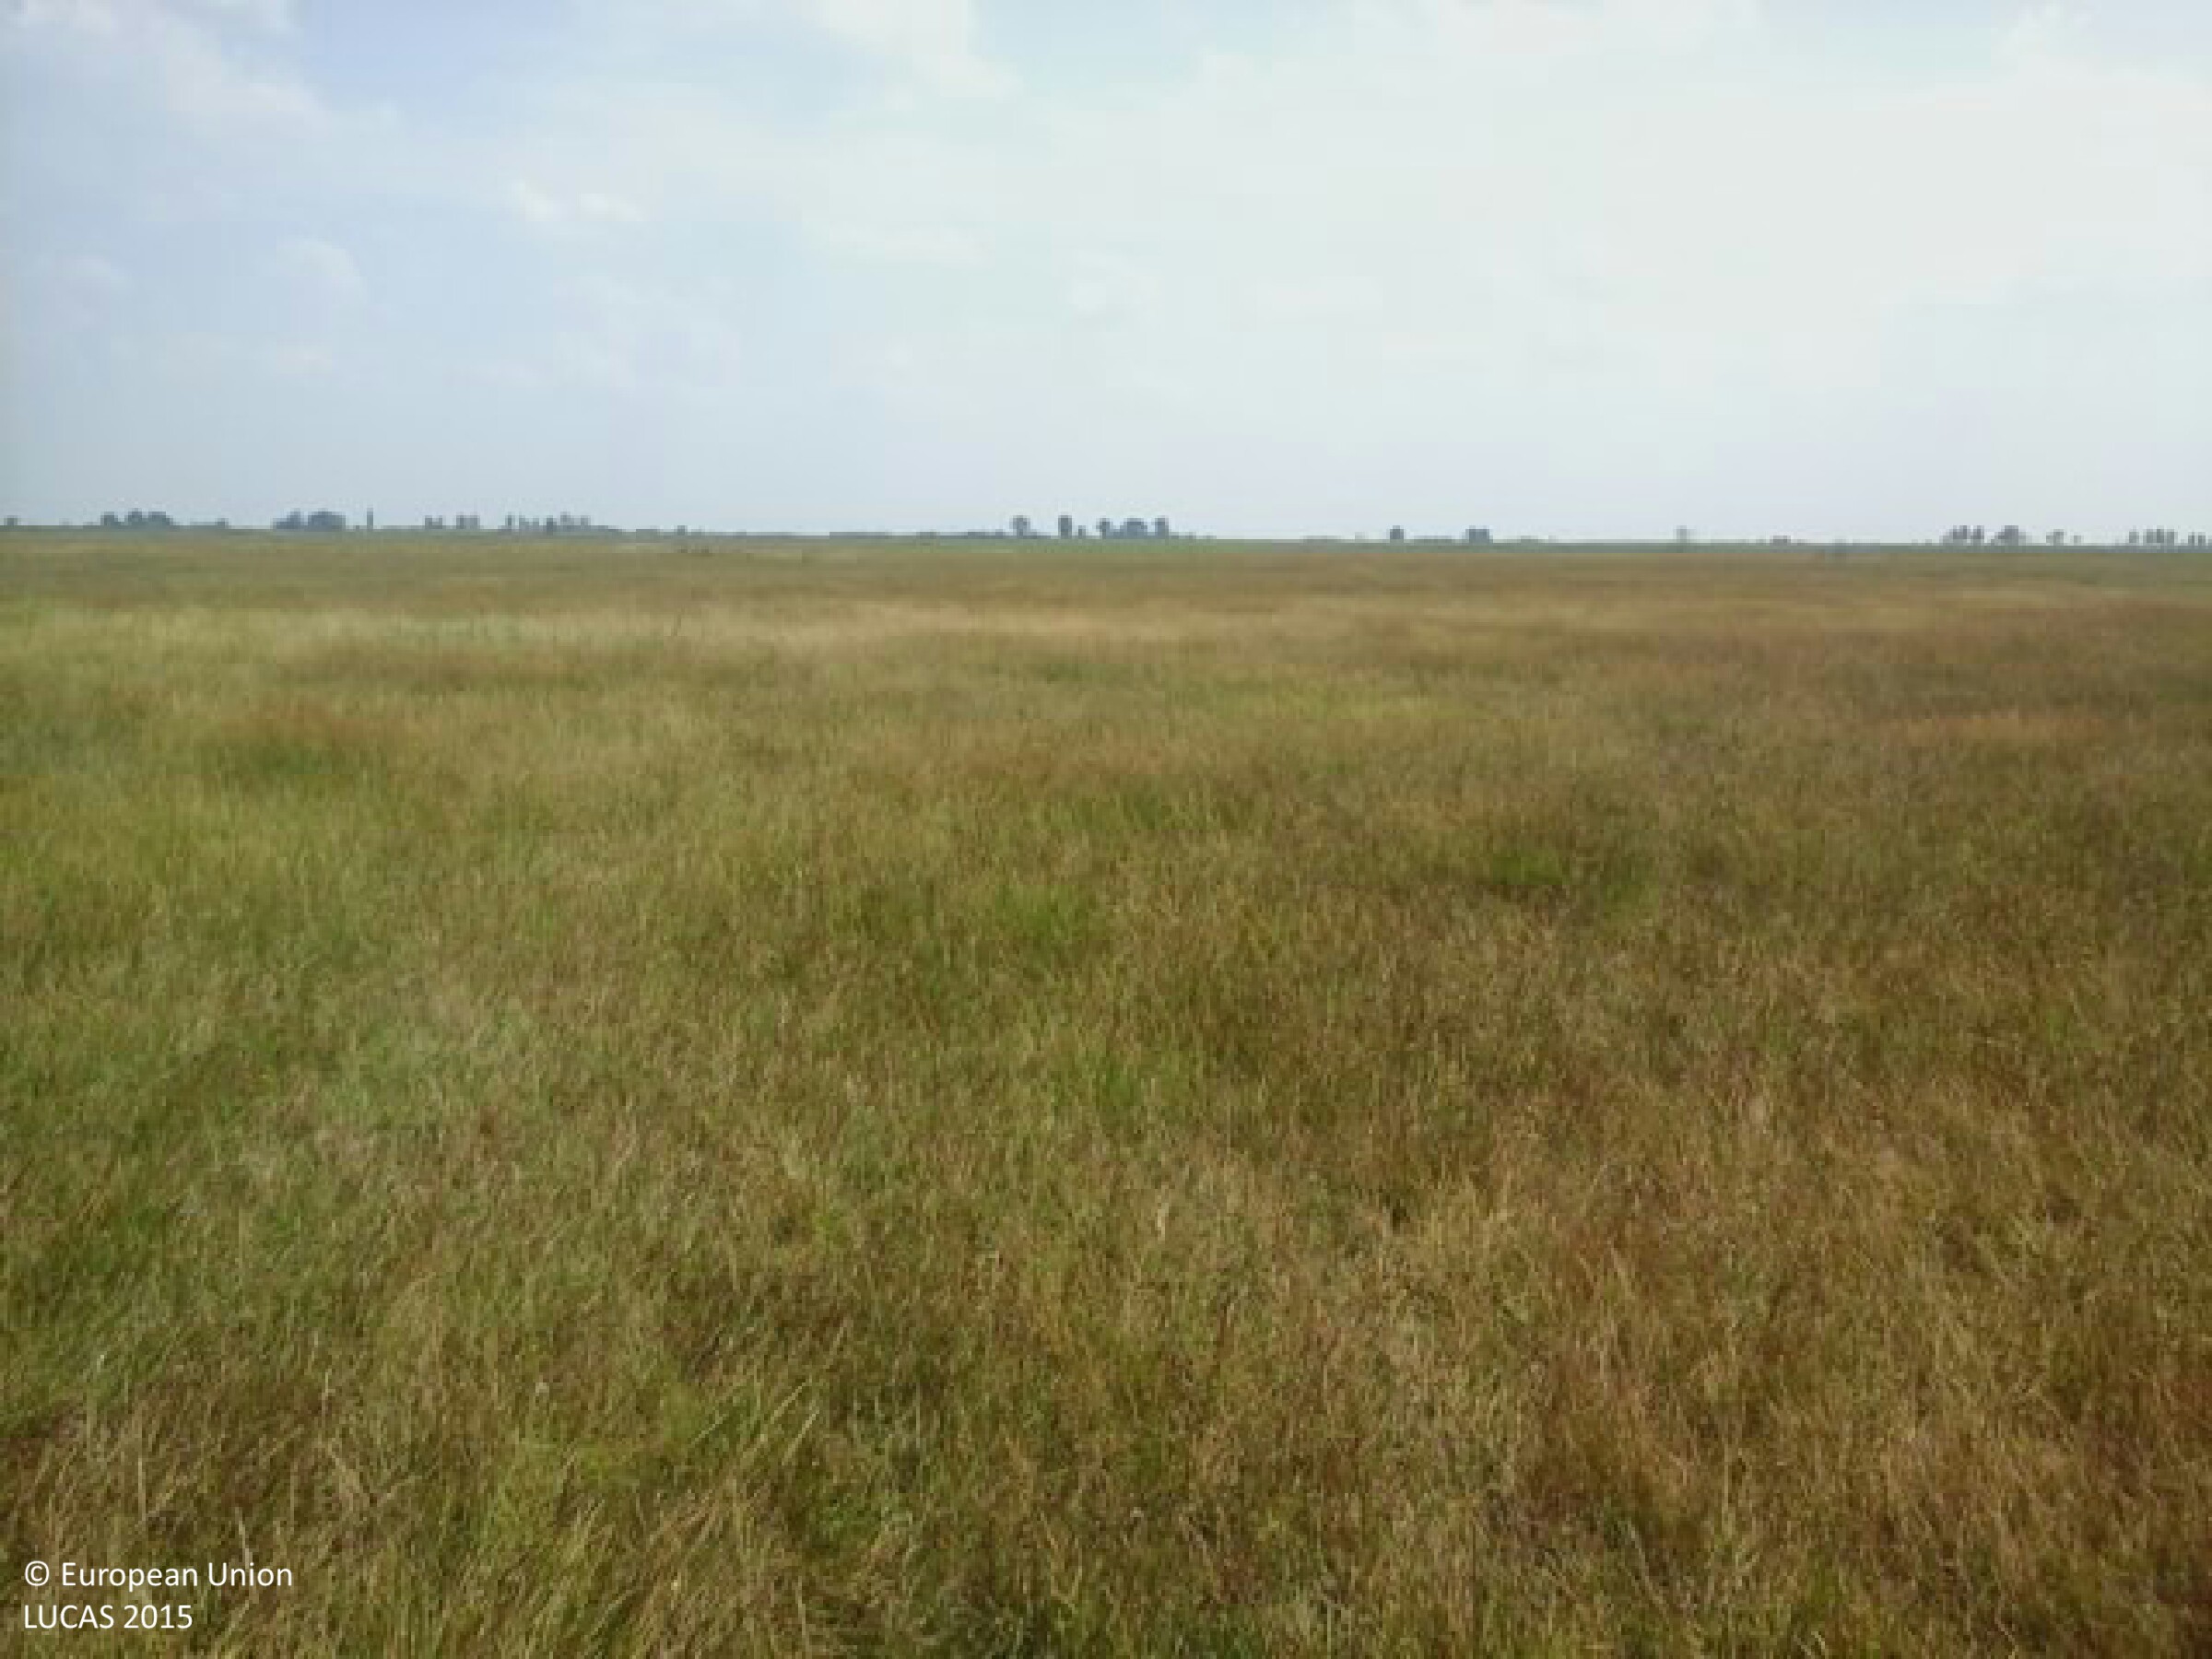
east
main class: Grassland
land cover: Grassland without tree/shrub cover
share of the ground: > 75 %
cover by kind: herbaceous plants 100 %
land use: Agriculture (excluding fallow land and kitchen gardens)
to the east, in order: Grassland without tree/shrub cover; Tracks; Grassland without tree/shrub cover
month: August
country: HU
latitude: 47.0709
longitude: 19.0631
